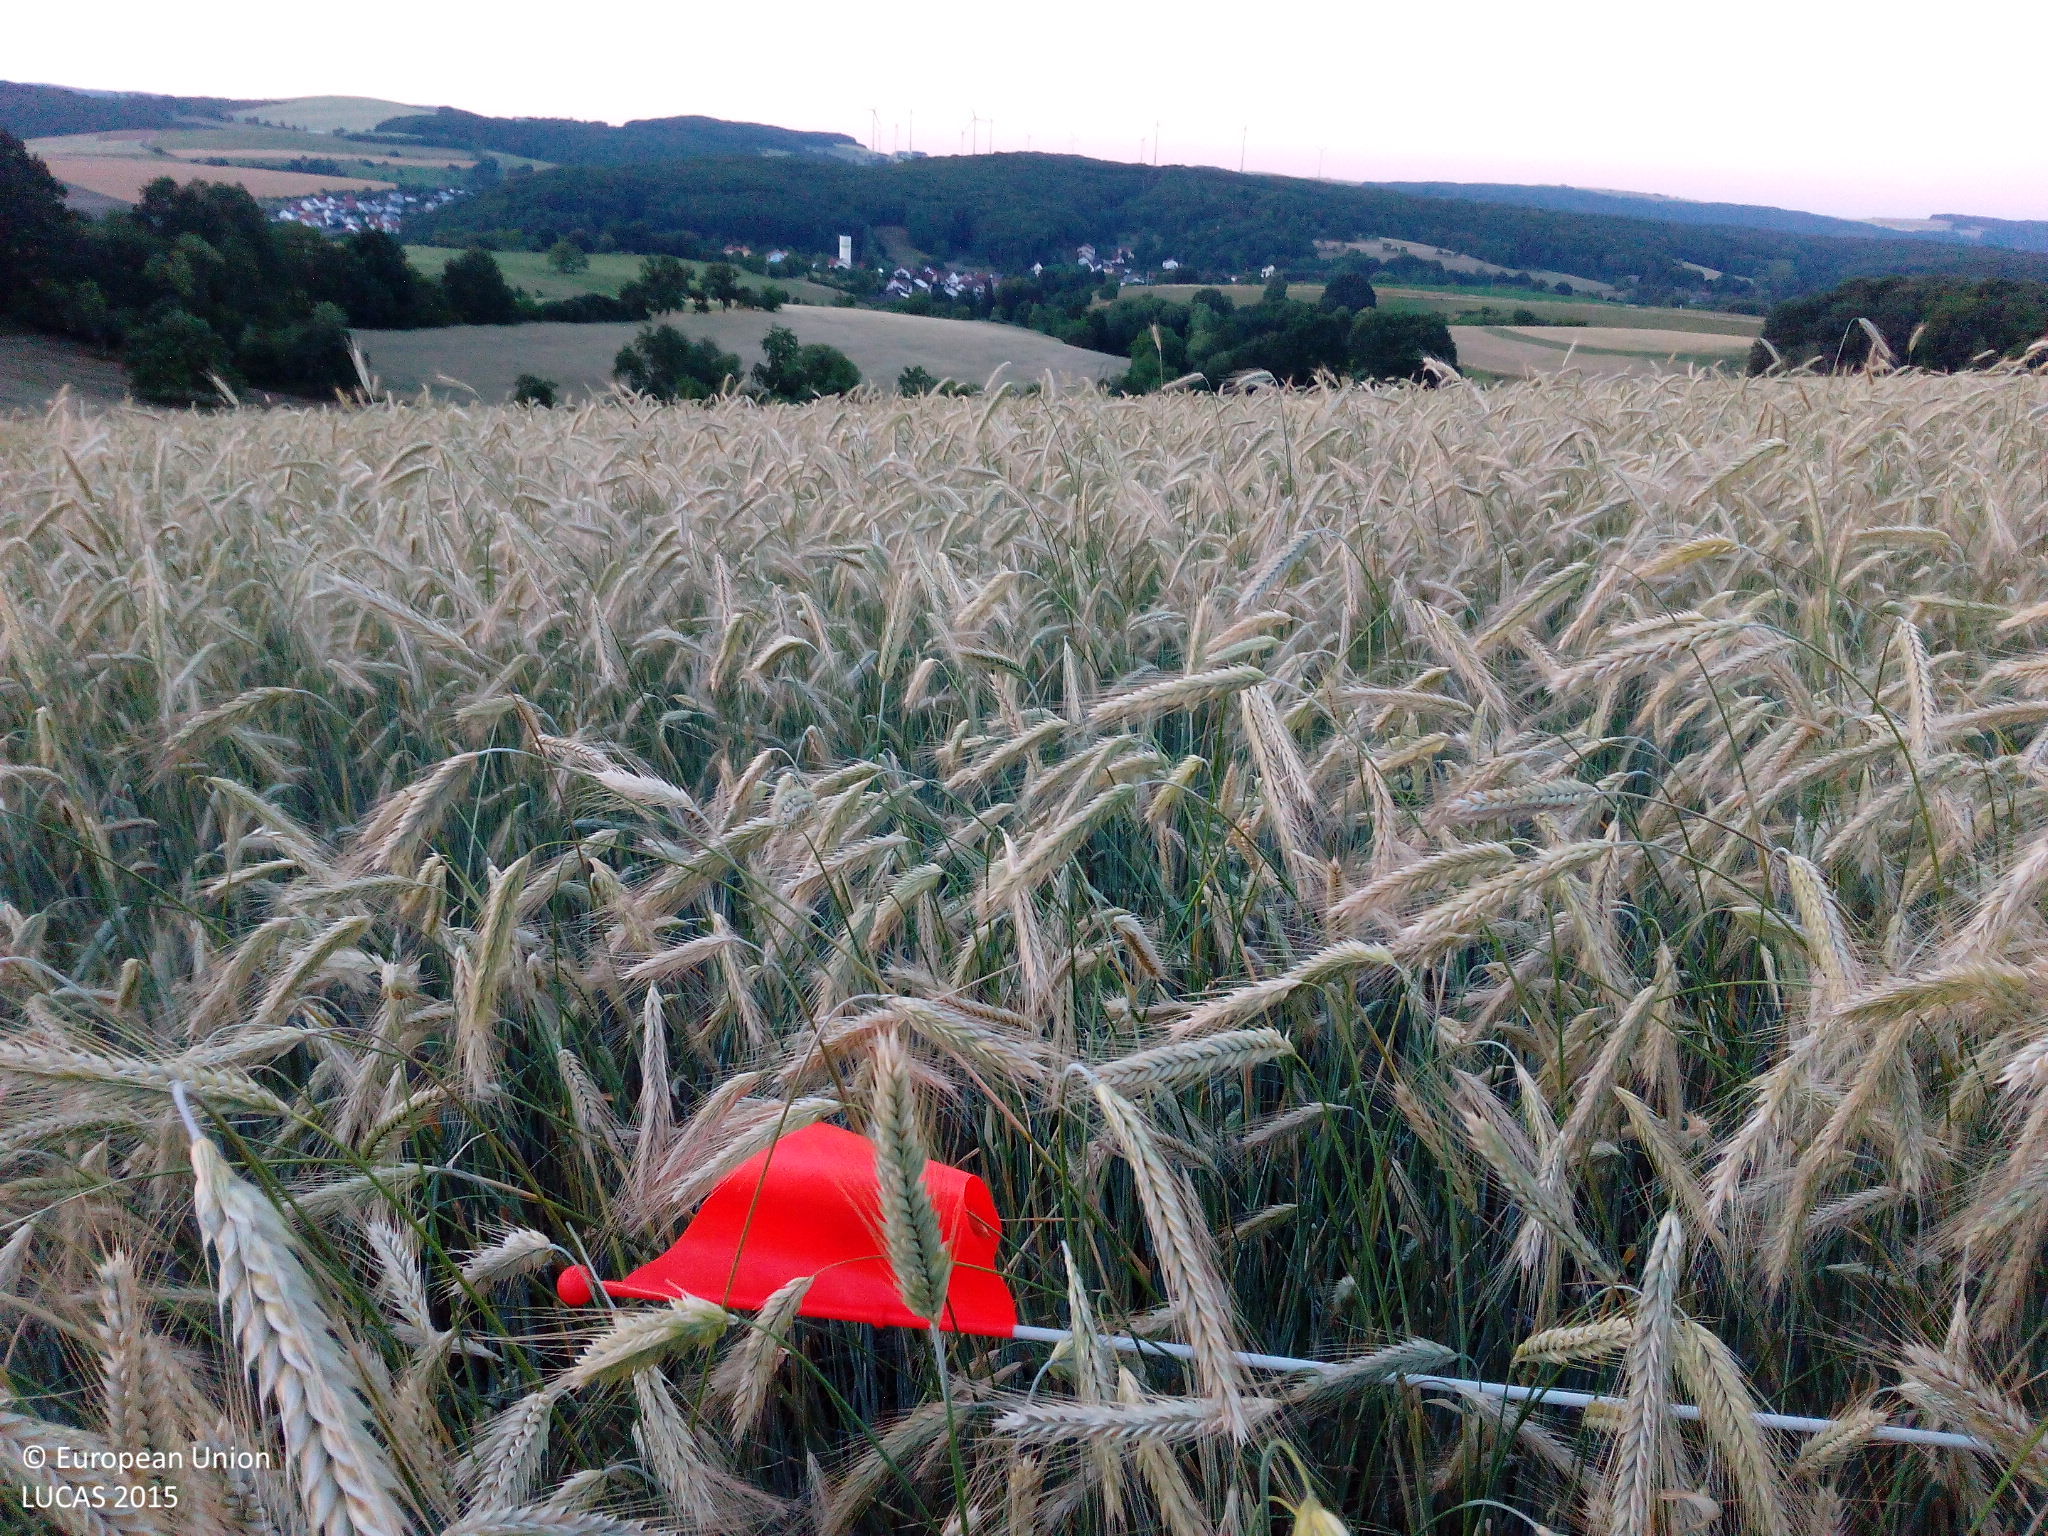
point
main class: Cropland
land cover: Barley
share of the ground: > 75 %
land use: Agriculture (excluding fallow land and kitchen gardens)
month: June
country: DE
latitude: 49.4918
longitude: 7.5292
